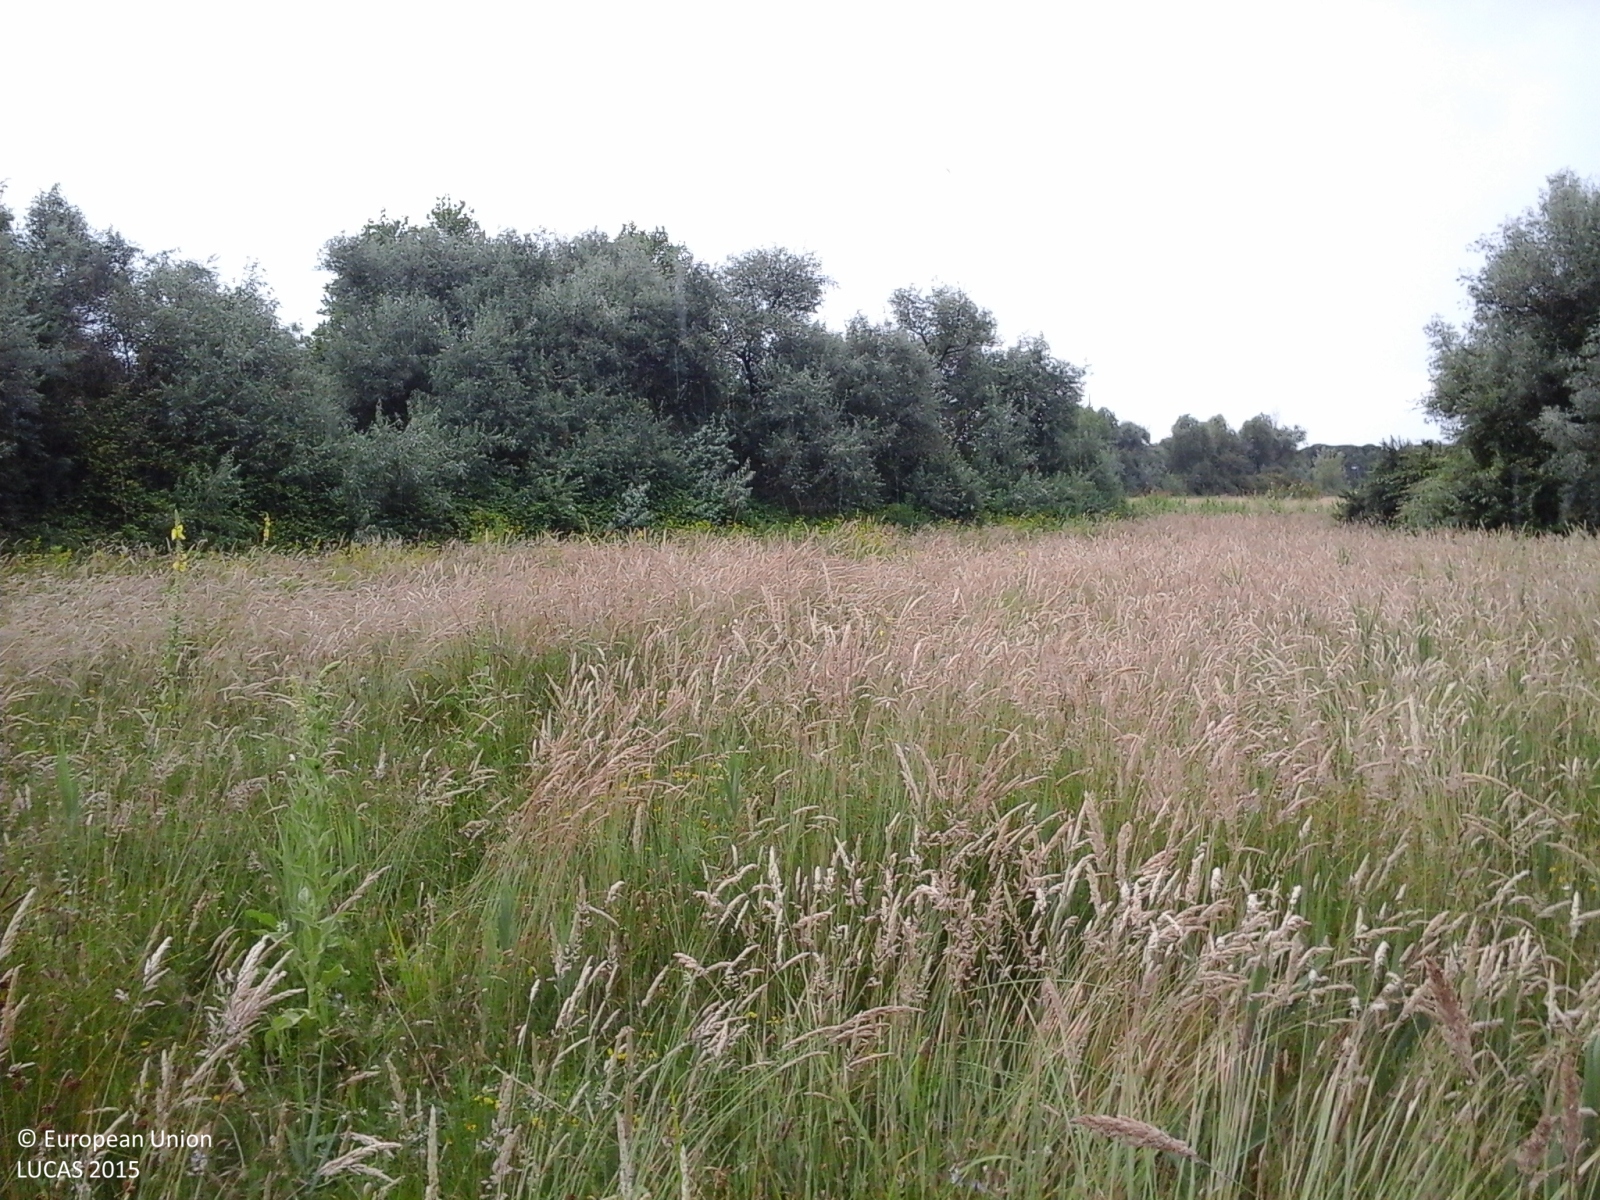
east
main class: Grassland
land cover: Grassland without tree/shrub cover
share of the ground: > 75 %
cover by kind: herbaceous plants 100 %
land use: Agriculture (excluding fallow land and kitchen gardens)
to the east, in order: Grassland without tree/shrub cover; Broadleaved woodland; Tracks; Broadleaved woodland; Spontaneously vegetated surfaces; Electric lines; Spontaneously vegetated surfaces; Shrubland without tree cover; Spontaneously vegetated surfaces
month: June
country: IT
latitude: 44.5968
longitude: 12.2505
